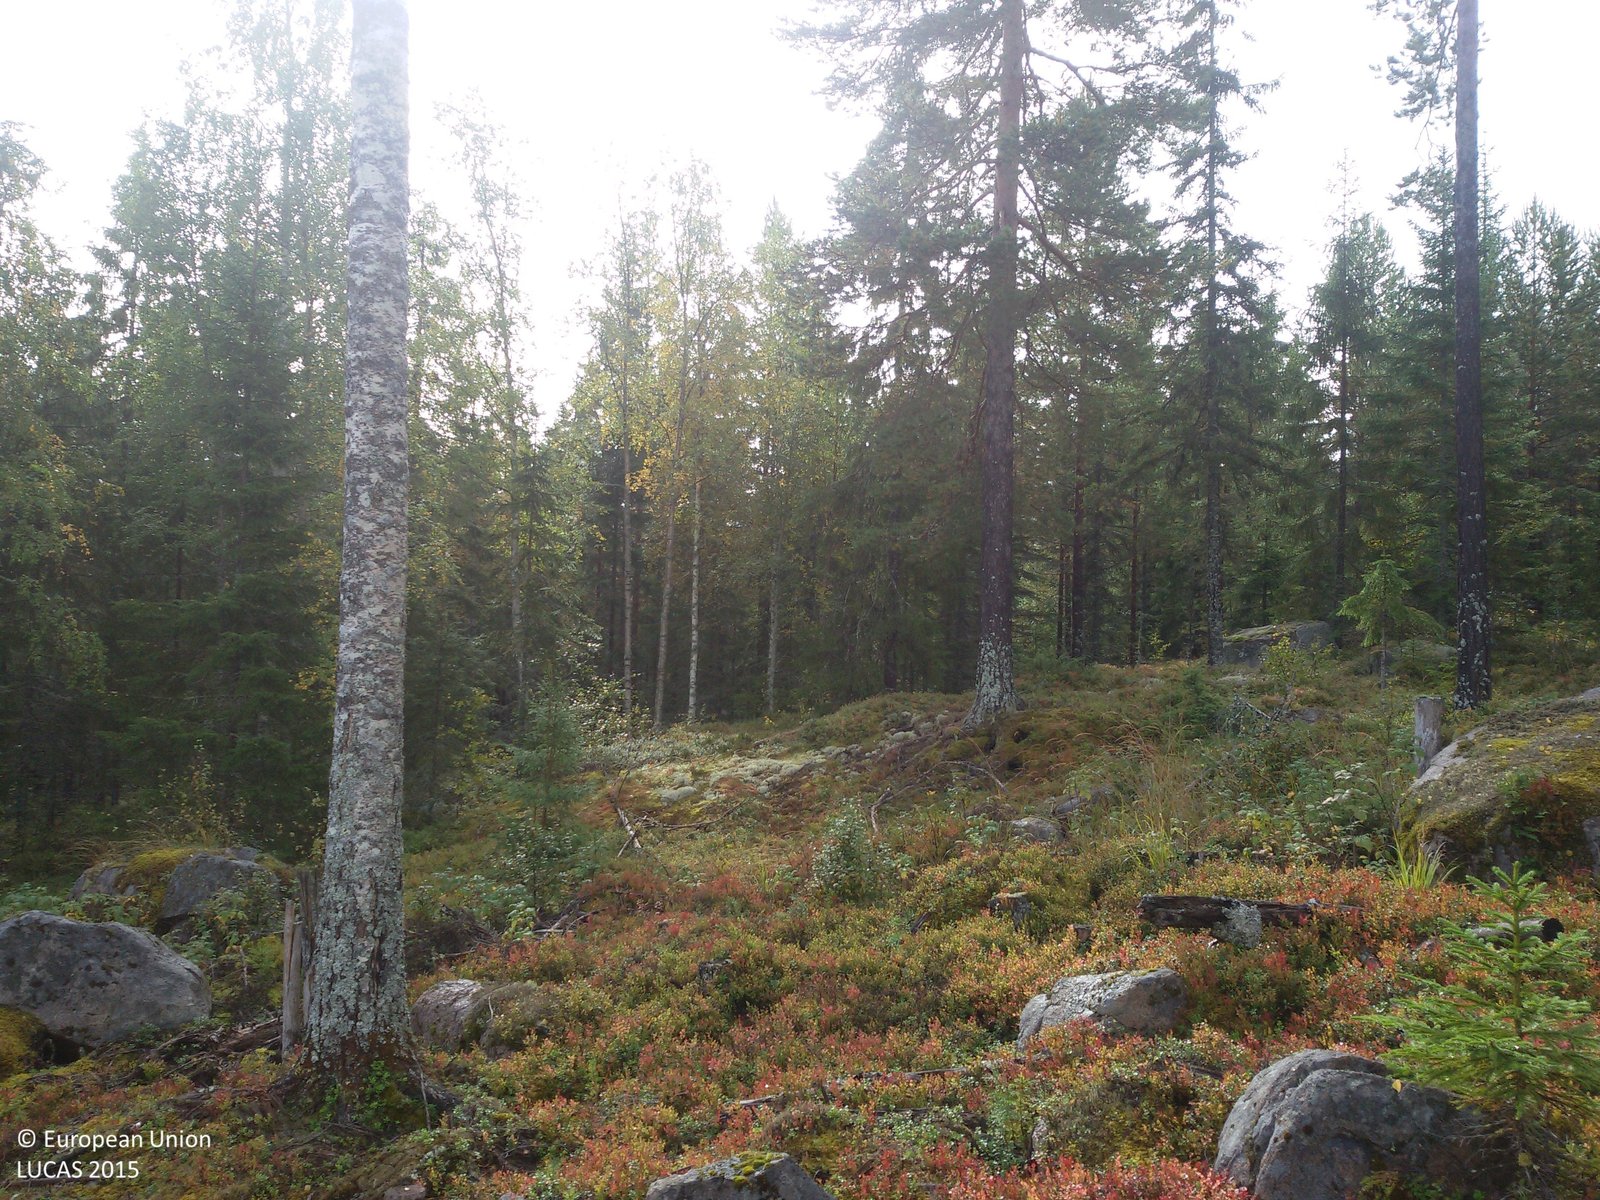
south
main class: Woodland
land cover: Spruce dominated mixed woodland
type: boreal forest
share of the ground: 50 - 75 %
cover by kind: coniferous forest trees 30 %, shrubs 30 %, broadleaved forest trees 20 %, herbaceous plants 20 %
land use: Forestry
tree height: < 5 m
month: September
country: SE
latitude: 60.8091
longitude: 14.6007
